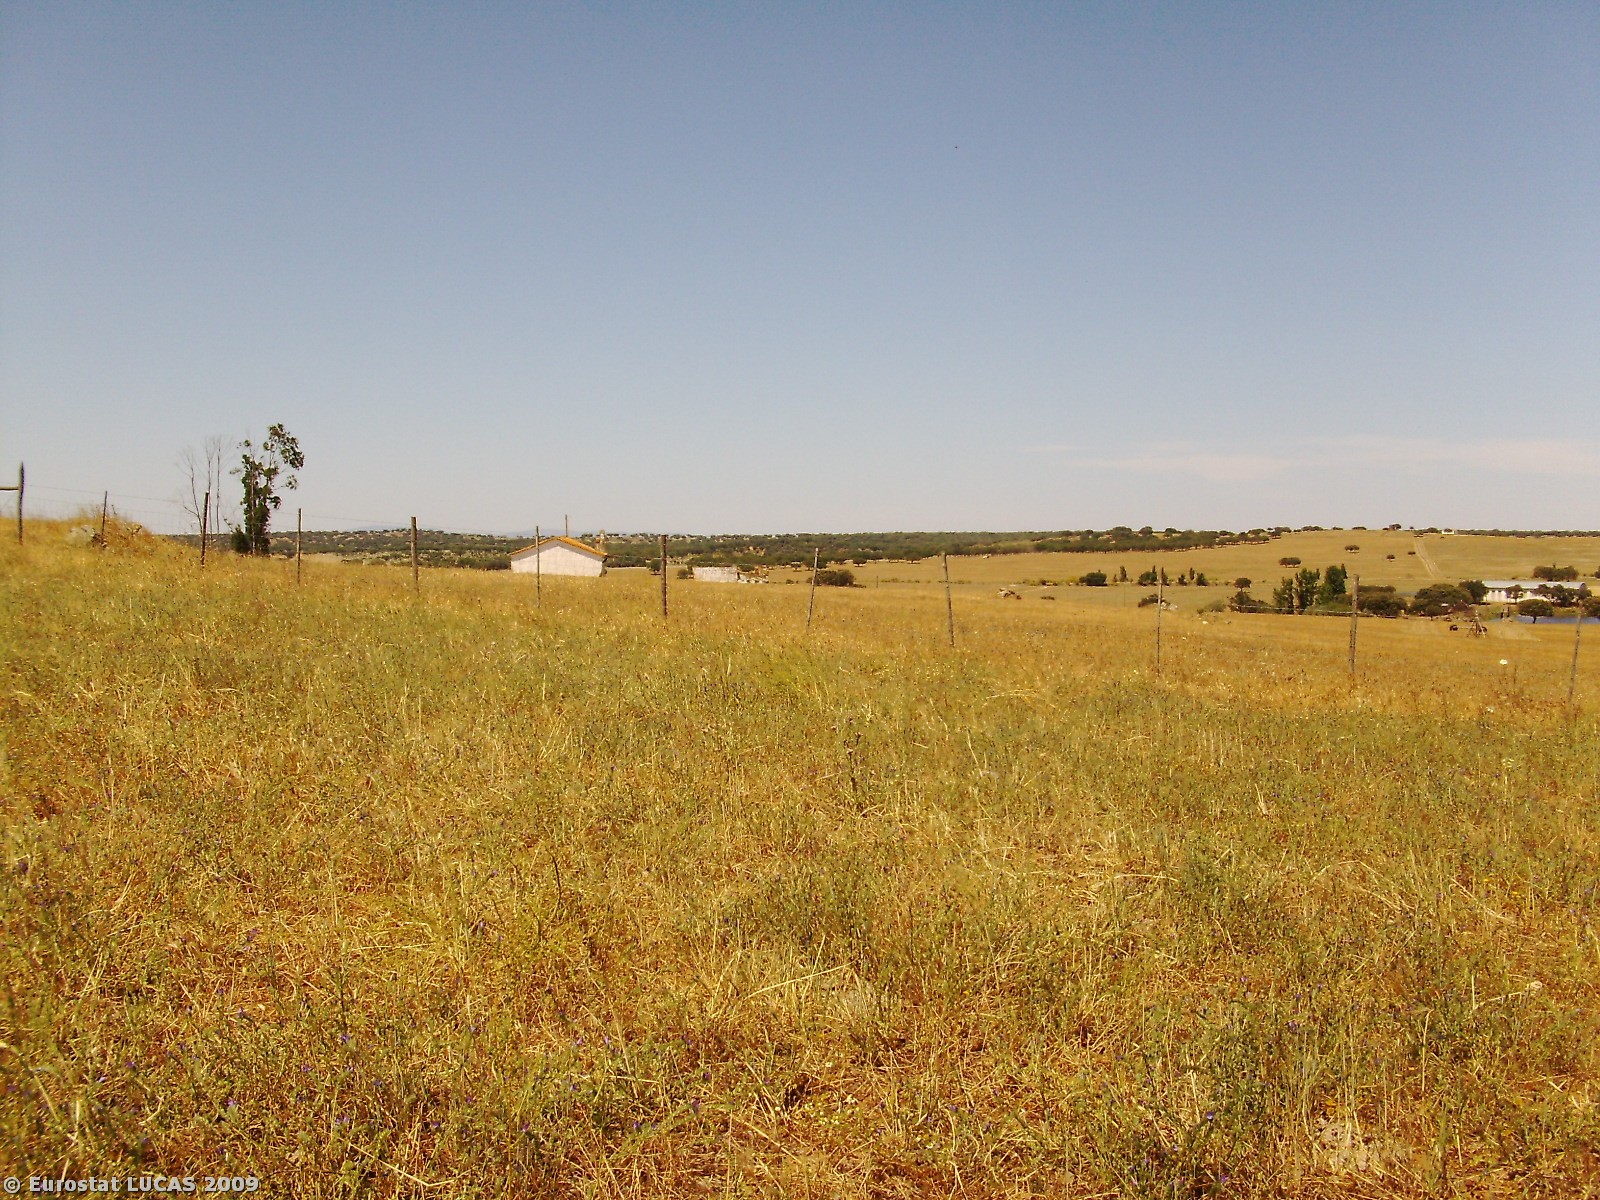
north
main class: Grassland
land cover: Spontaneously vegetated surfaces
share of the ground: > 75 %
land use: Fallow land
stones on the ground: 10 - 25 %
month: May
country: PT
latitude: 38.9084
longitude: -7.3653
